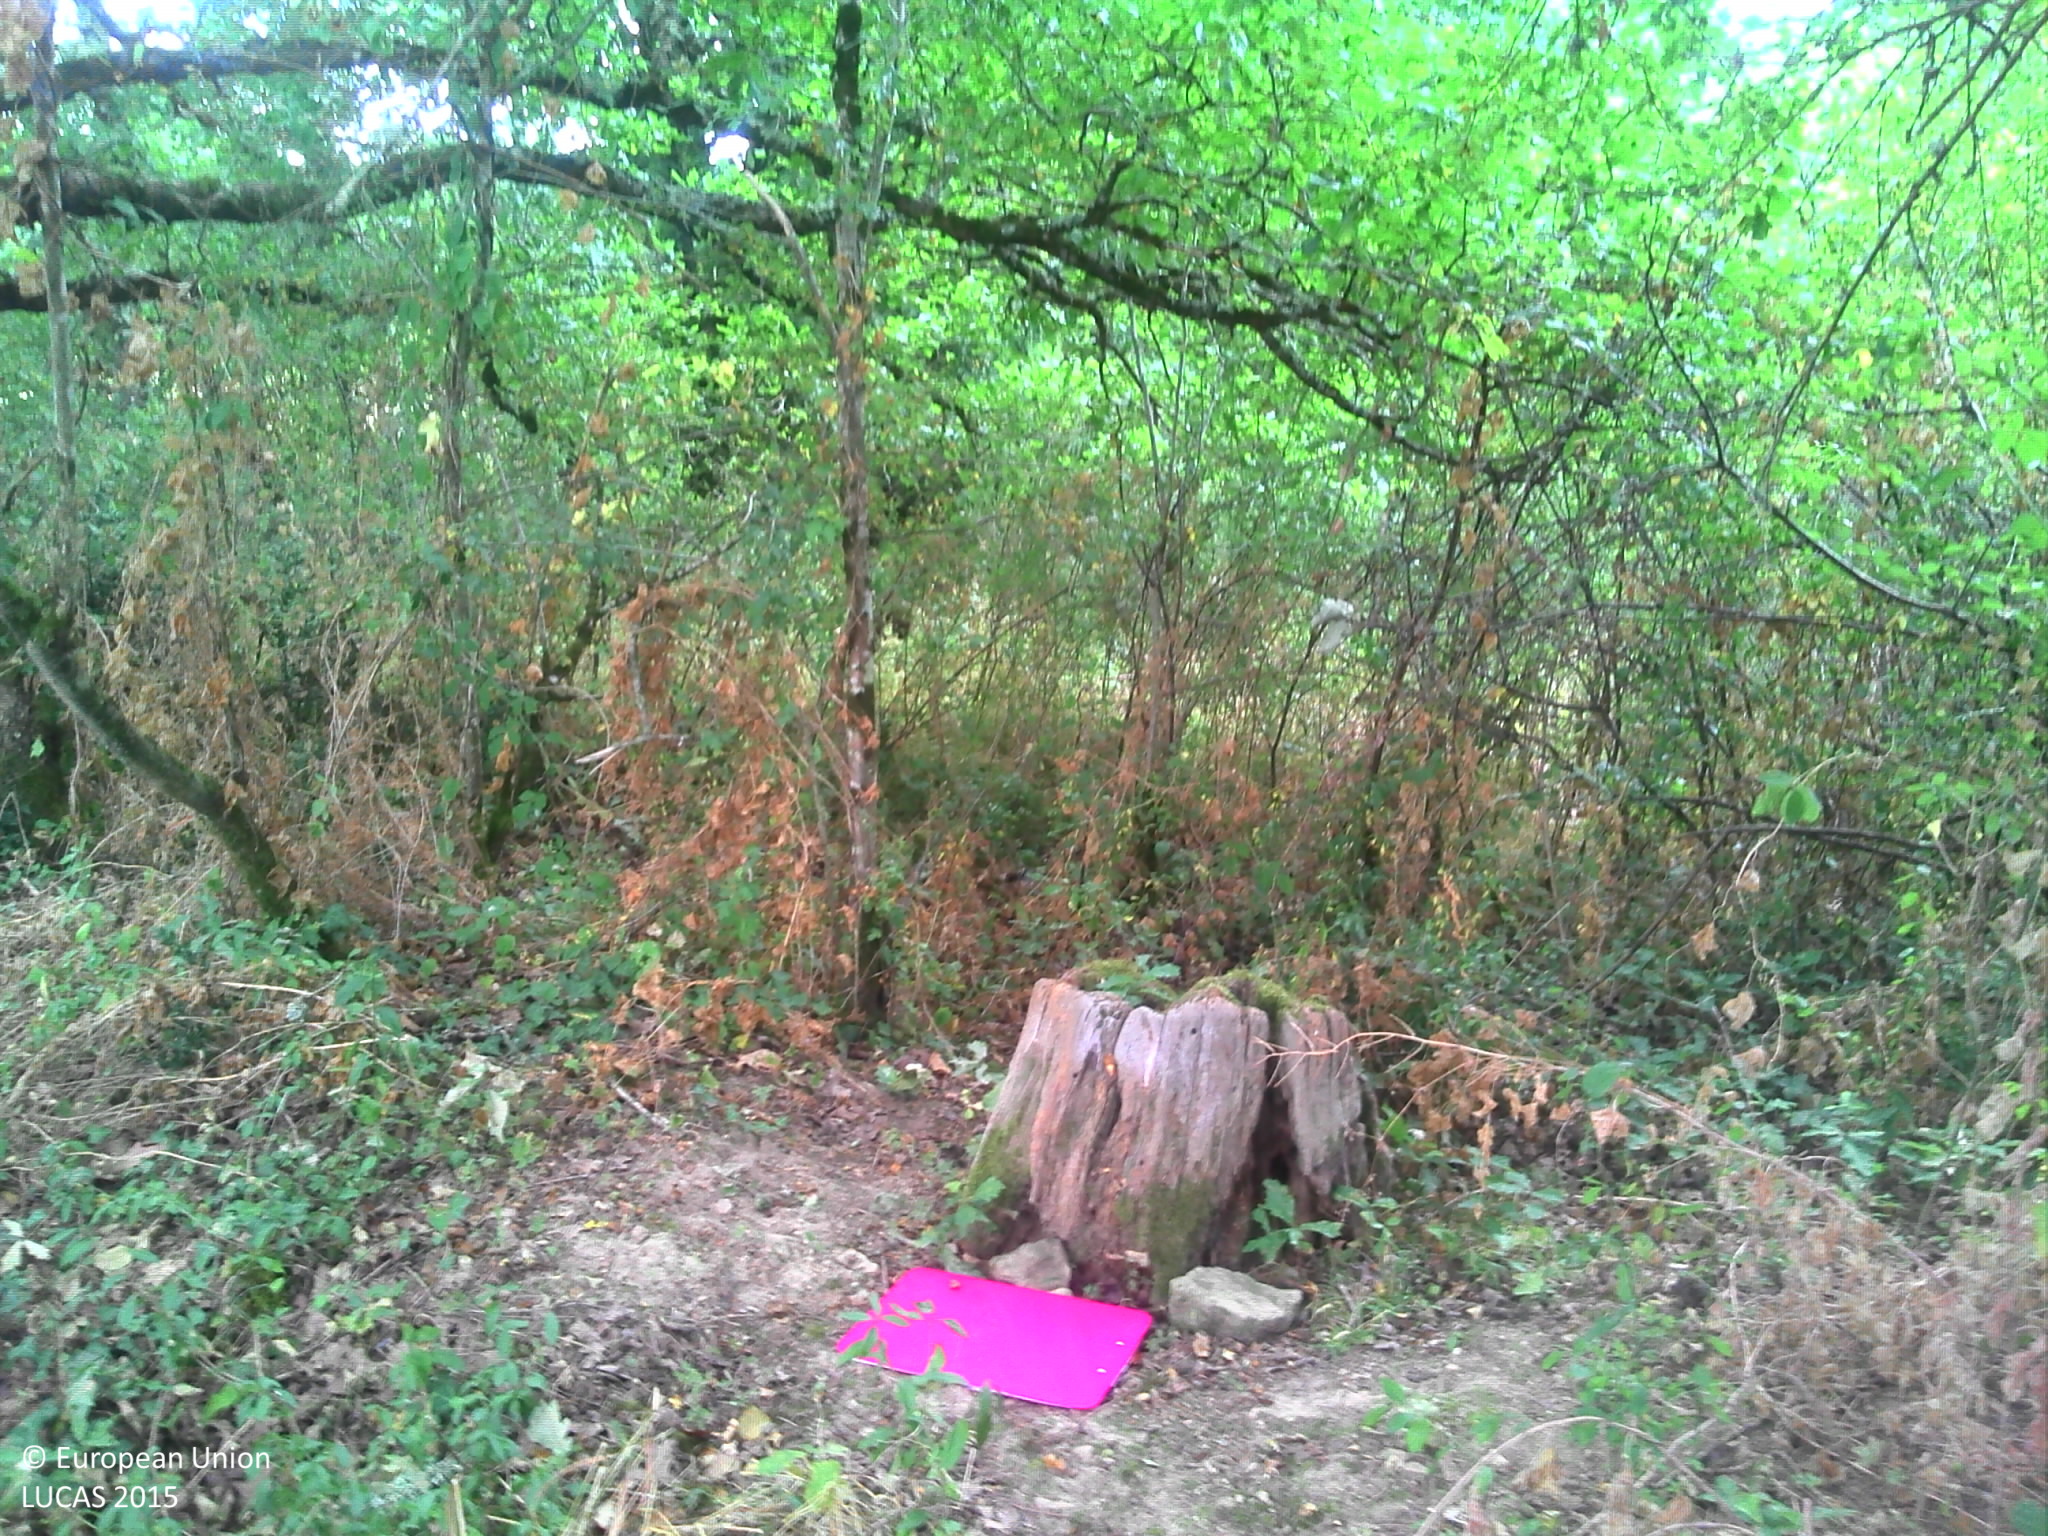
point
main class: Woodland
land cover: Broadleaved woodland
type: mesophytic deciduous forest
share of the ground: > 75 %
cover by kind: broadleaved forest trees 80 %, herbaceous plants 15 %
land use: Forestry
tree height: > 5 m
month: October
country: FR
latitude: 46.3316
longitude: 1.1940
